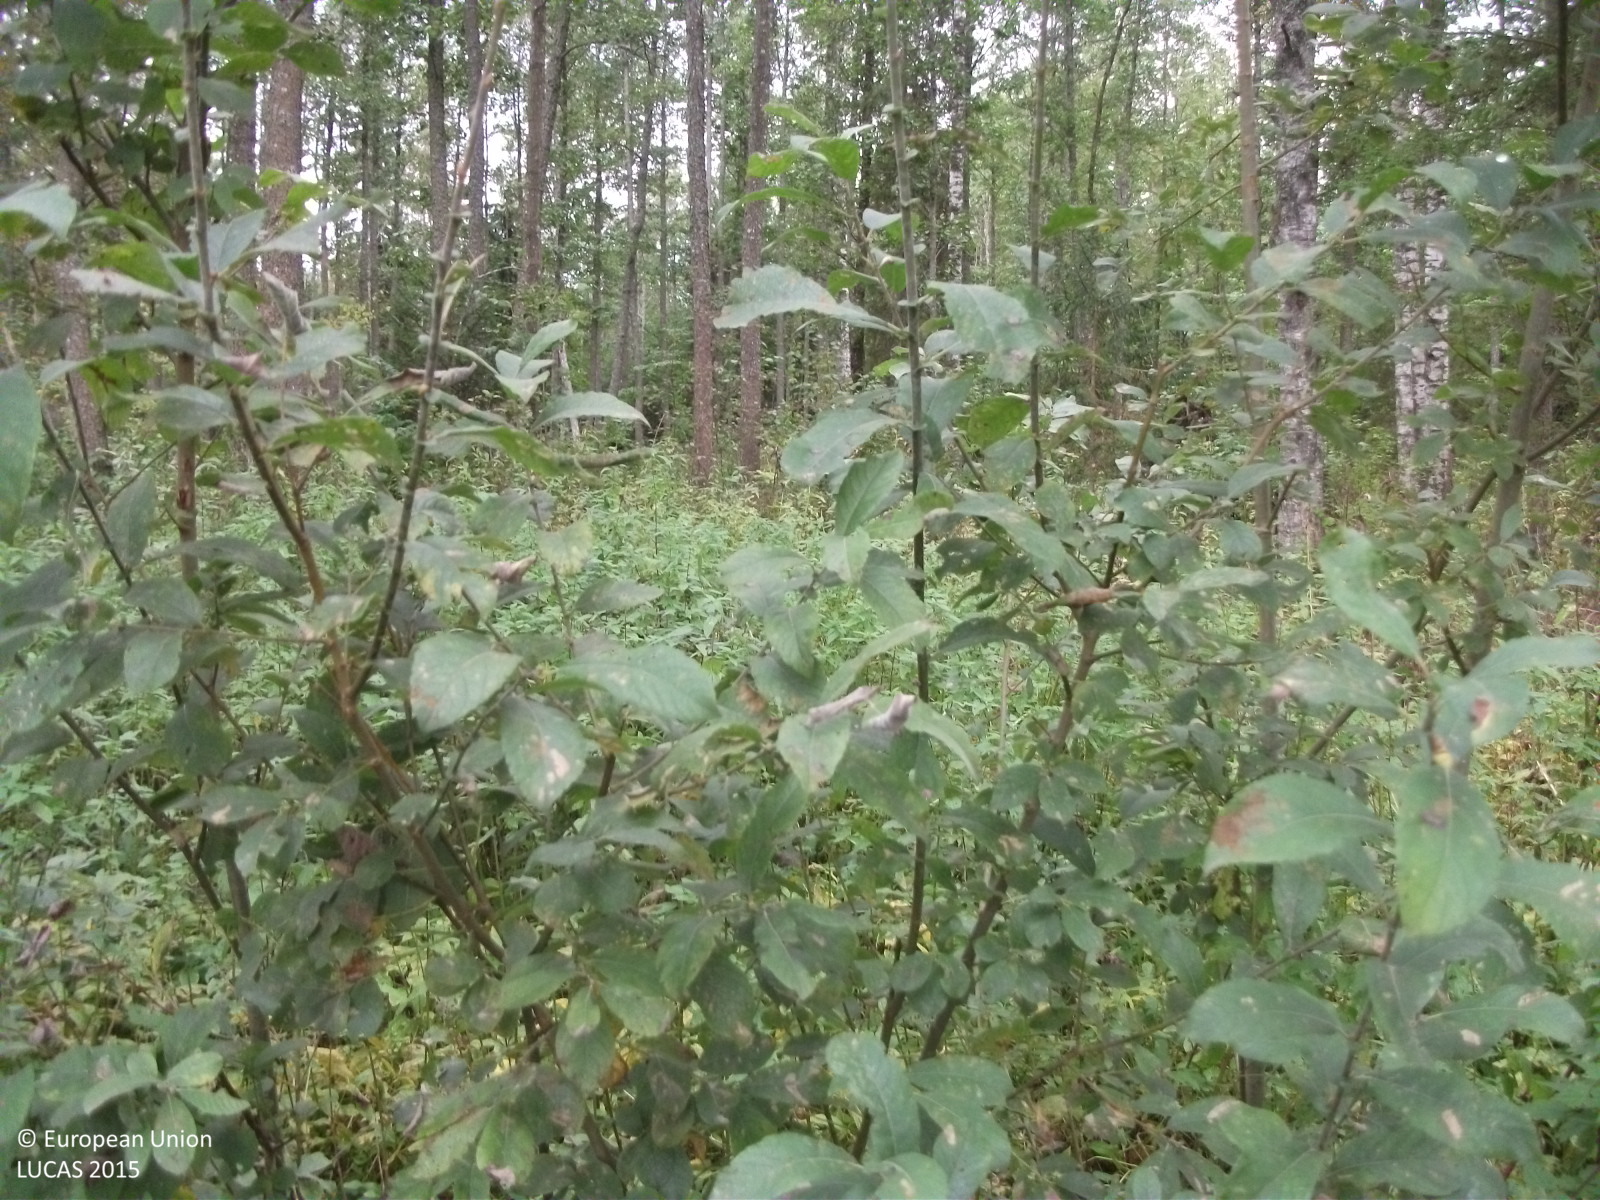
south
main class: Woodland
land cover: Broadleaved woodland
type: non-riverine alder, birch or aspen forest
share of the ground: 50 - 75 %
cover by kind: broadleaved forest trees 70 %, herbaceous plants 20 %, shrubs 10 %
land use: Forestry
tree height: > 5 m
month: September
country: LV
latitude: 57.7498
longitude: 24.7295
